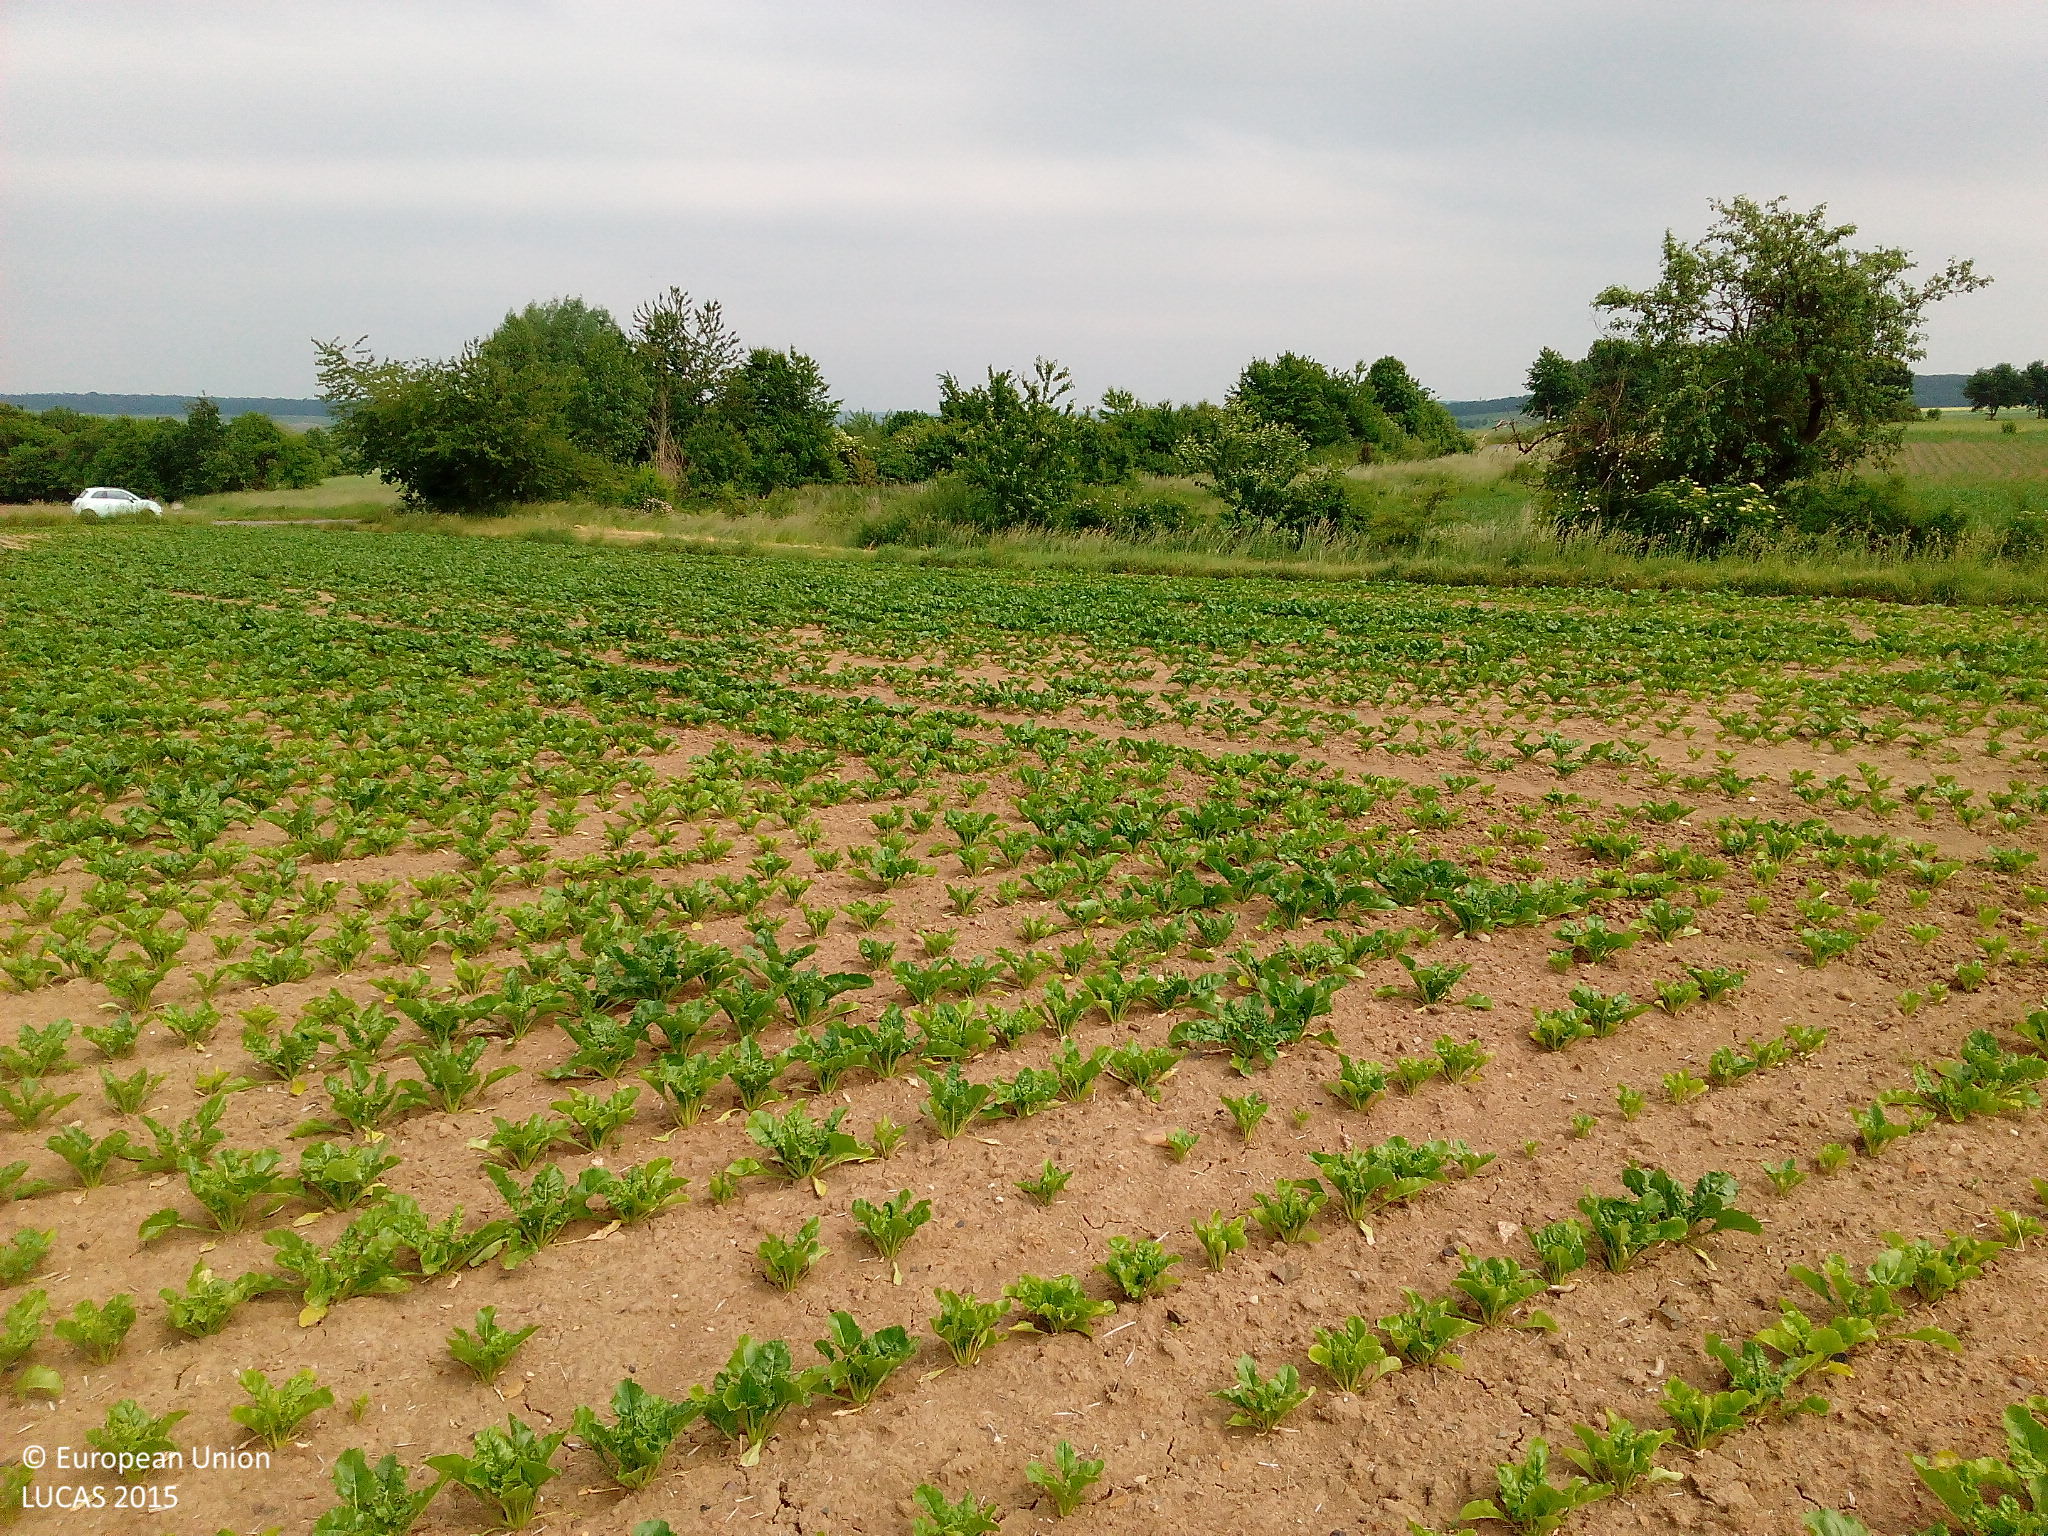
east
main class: Cropland
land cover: Sugar beet
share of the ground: 25 - 50 %
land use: Agriculture (excluding fallow land and kitchen gardens)
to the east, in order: Sugar beet; Grass margins; Tracks; Grass margins; Shrubland with sparse tree cover; Ditches and canals; Shrubland with sparse tree cover; Grassland without tree/shrub cover; Ditches and canals; Shrubland with sparse tree cover; Paved roads, cycling and walking lanes; Grass margins; Broadleaved woodland; Grassland without tree/shrub cover; Broadleaved woodland; Ditches and canals; Broadleaved woodland; Apple fruit; Grass margins; Rape and turnip rape
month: June
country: DE
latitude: 51.1534
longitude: 9.3568
